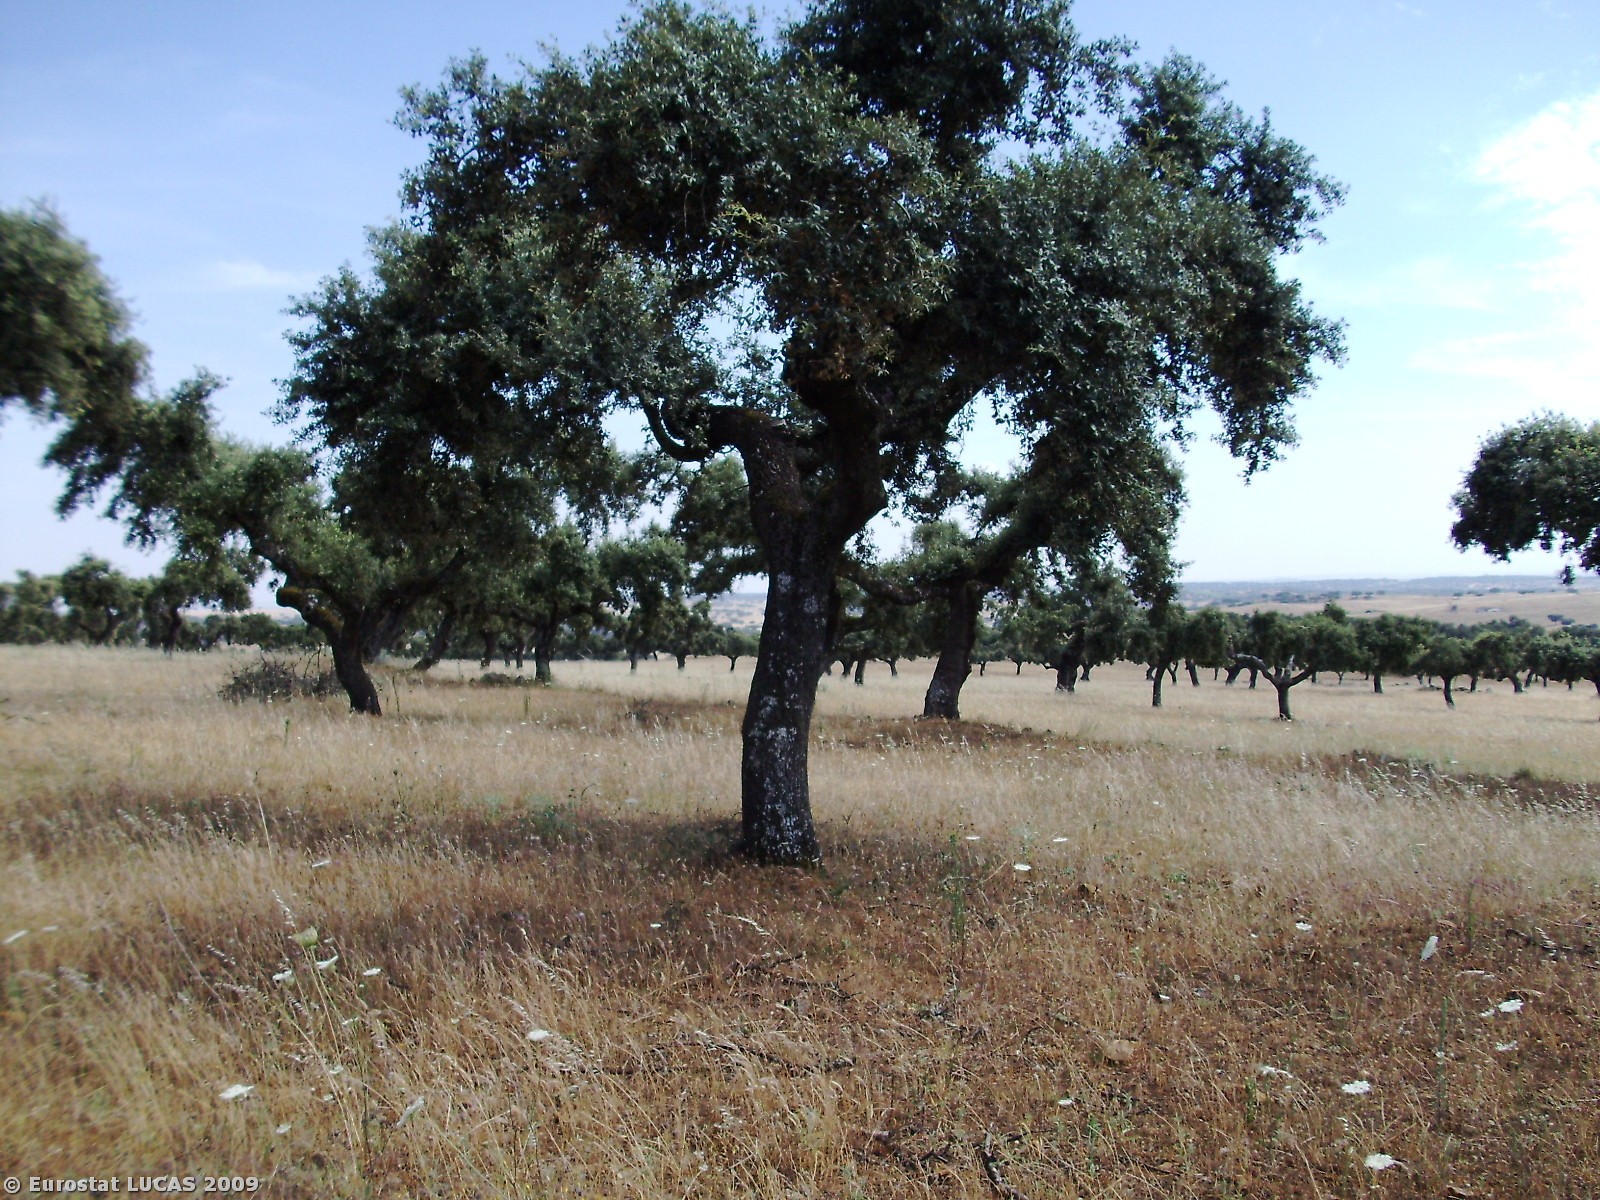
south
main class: Woodland
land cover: Broadleaved woodland
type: broadleaved evergreen forest
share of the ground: 10 - 25 %
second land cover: Spontaneously vegetated surfaces
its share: 50 - 75 %
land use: Forestry
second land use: Fallow land
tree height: > 5 m
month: June
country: PT
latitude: 39.1101
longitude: -7.3722
